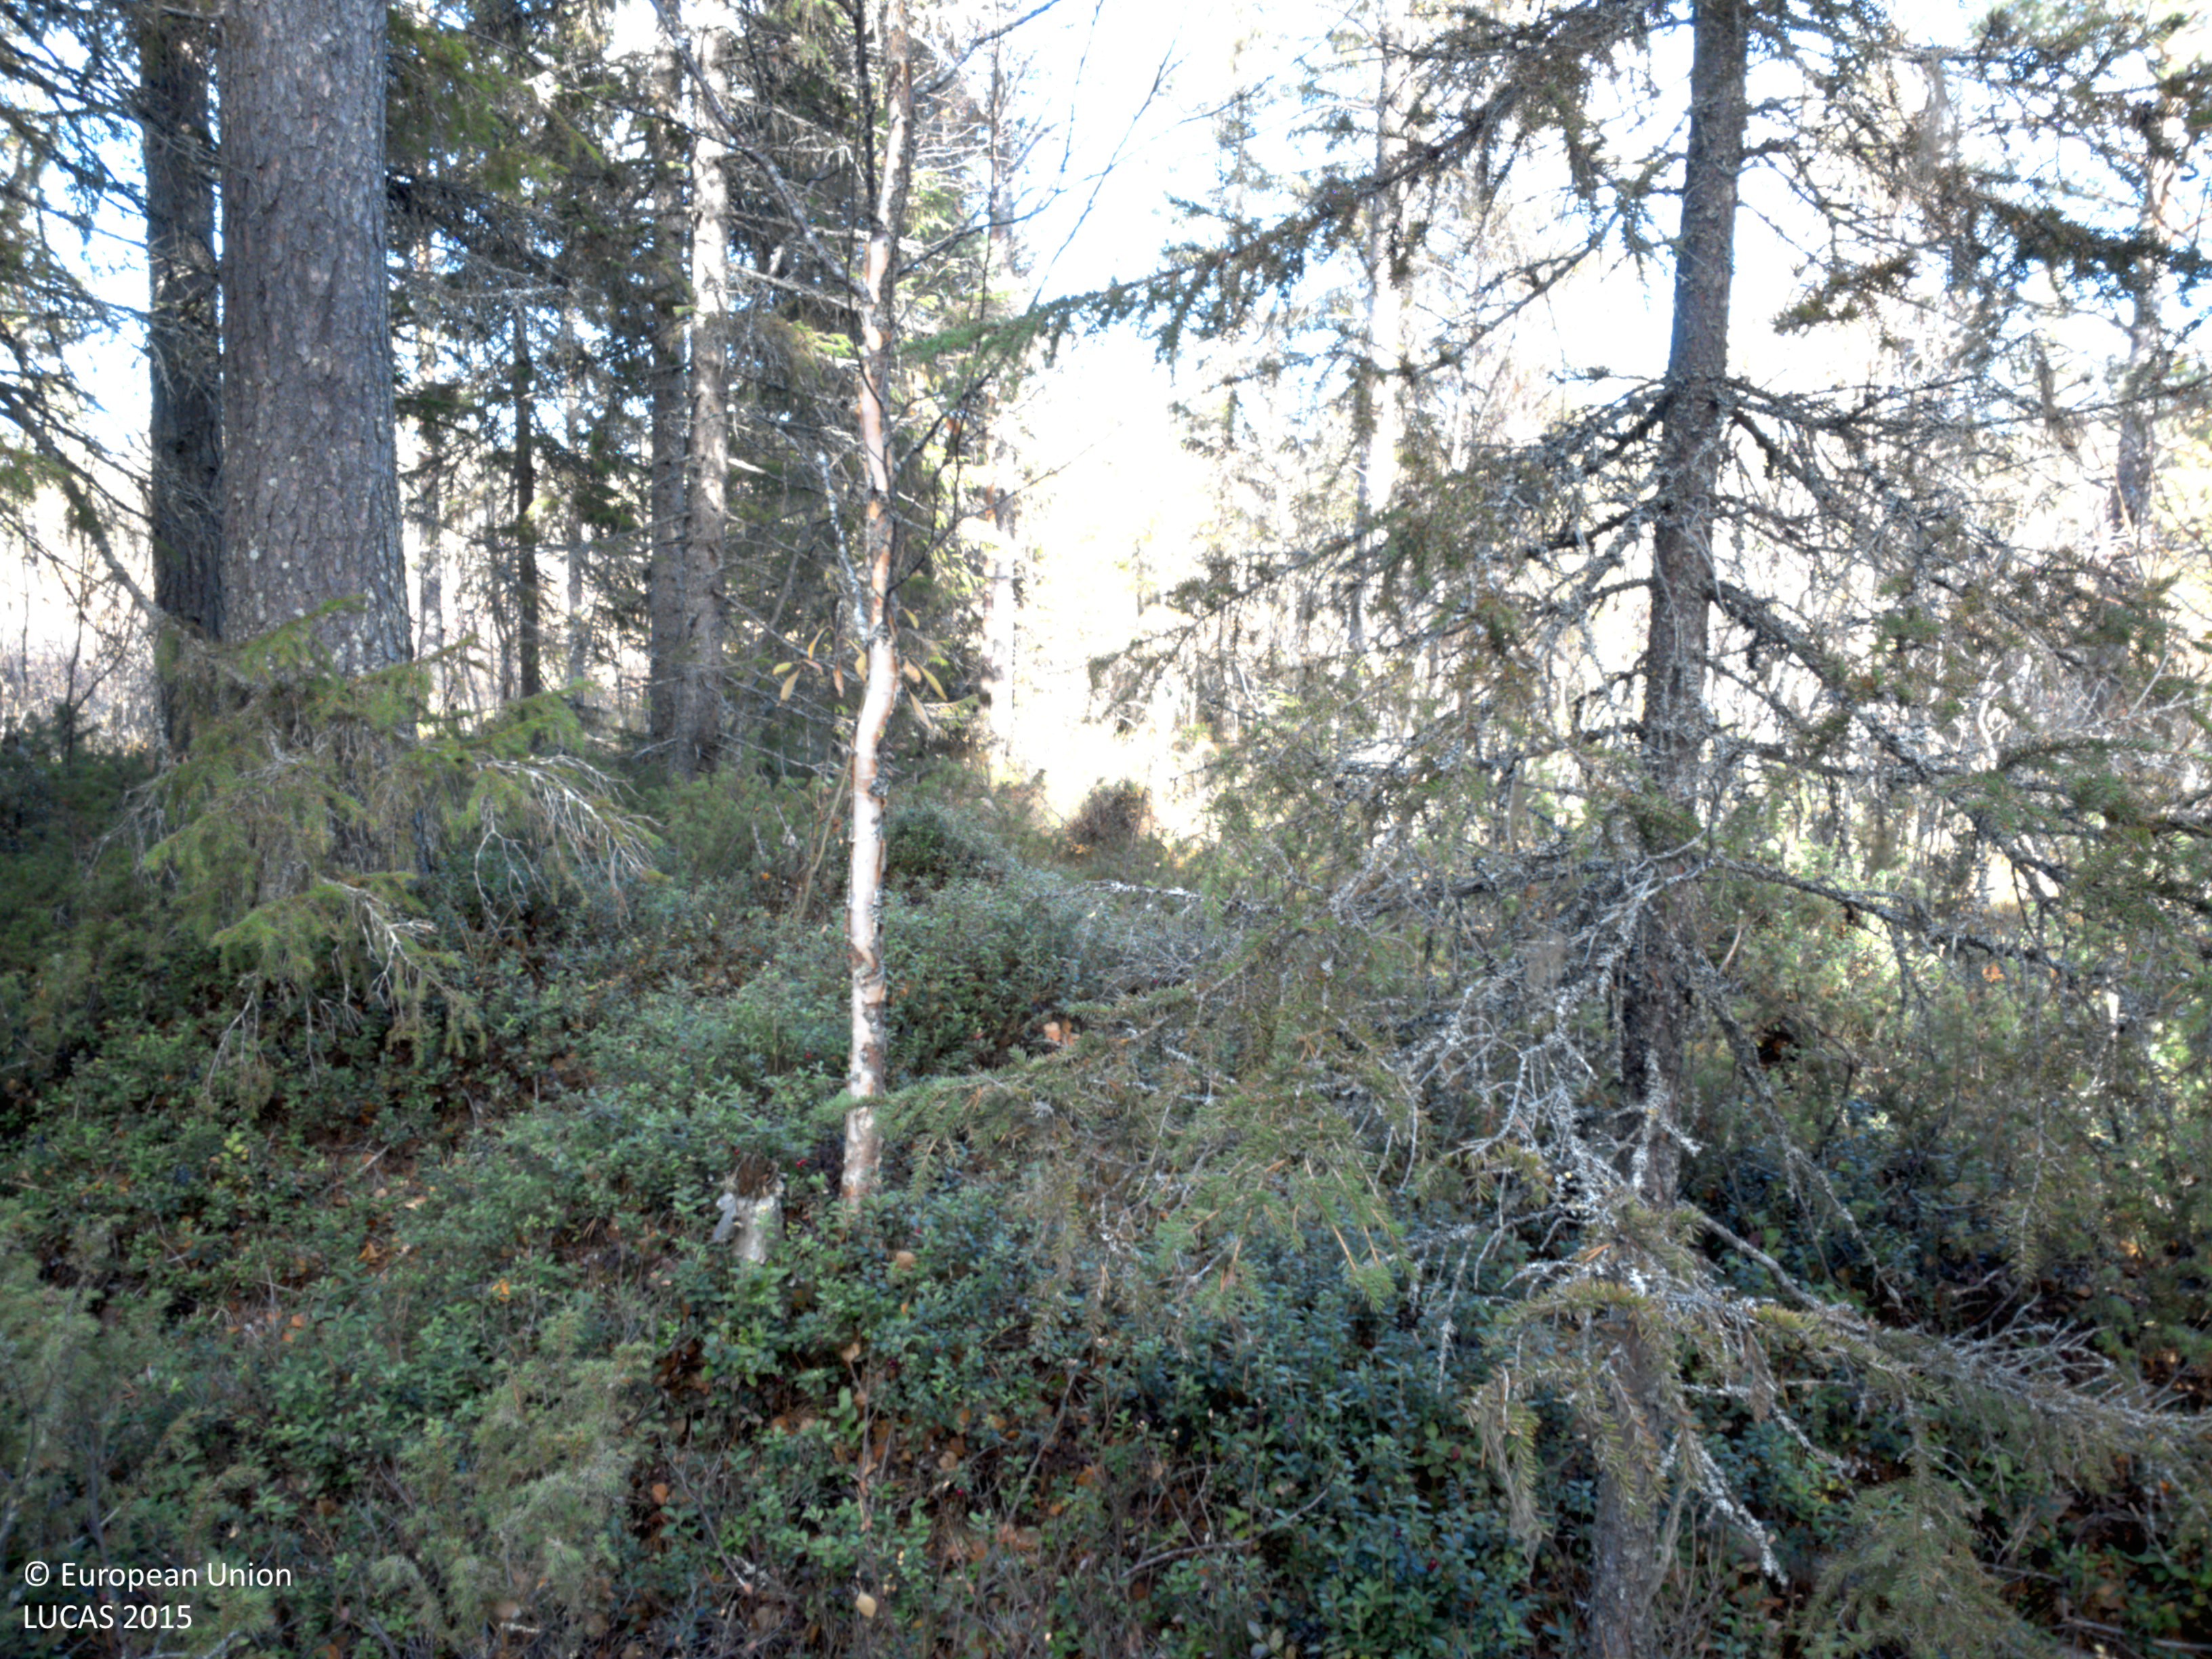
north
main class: Woodland
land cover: Other mixed woodland
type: boreal forest
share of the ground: 50 - 75 %
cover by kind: coniferous forest trees 45 %, shrubs 35 %, broadleaved forest trees 15 %, herbaceous plants 5 %
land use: Forestry
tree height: > 5 m
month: October
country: SE
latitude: 64.6312
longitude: 18.0203
